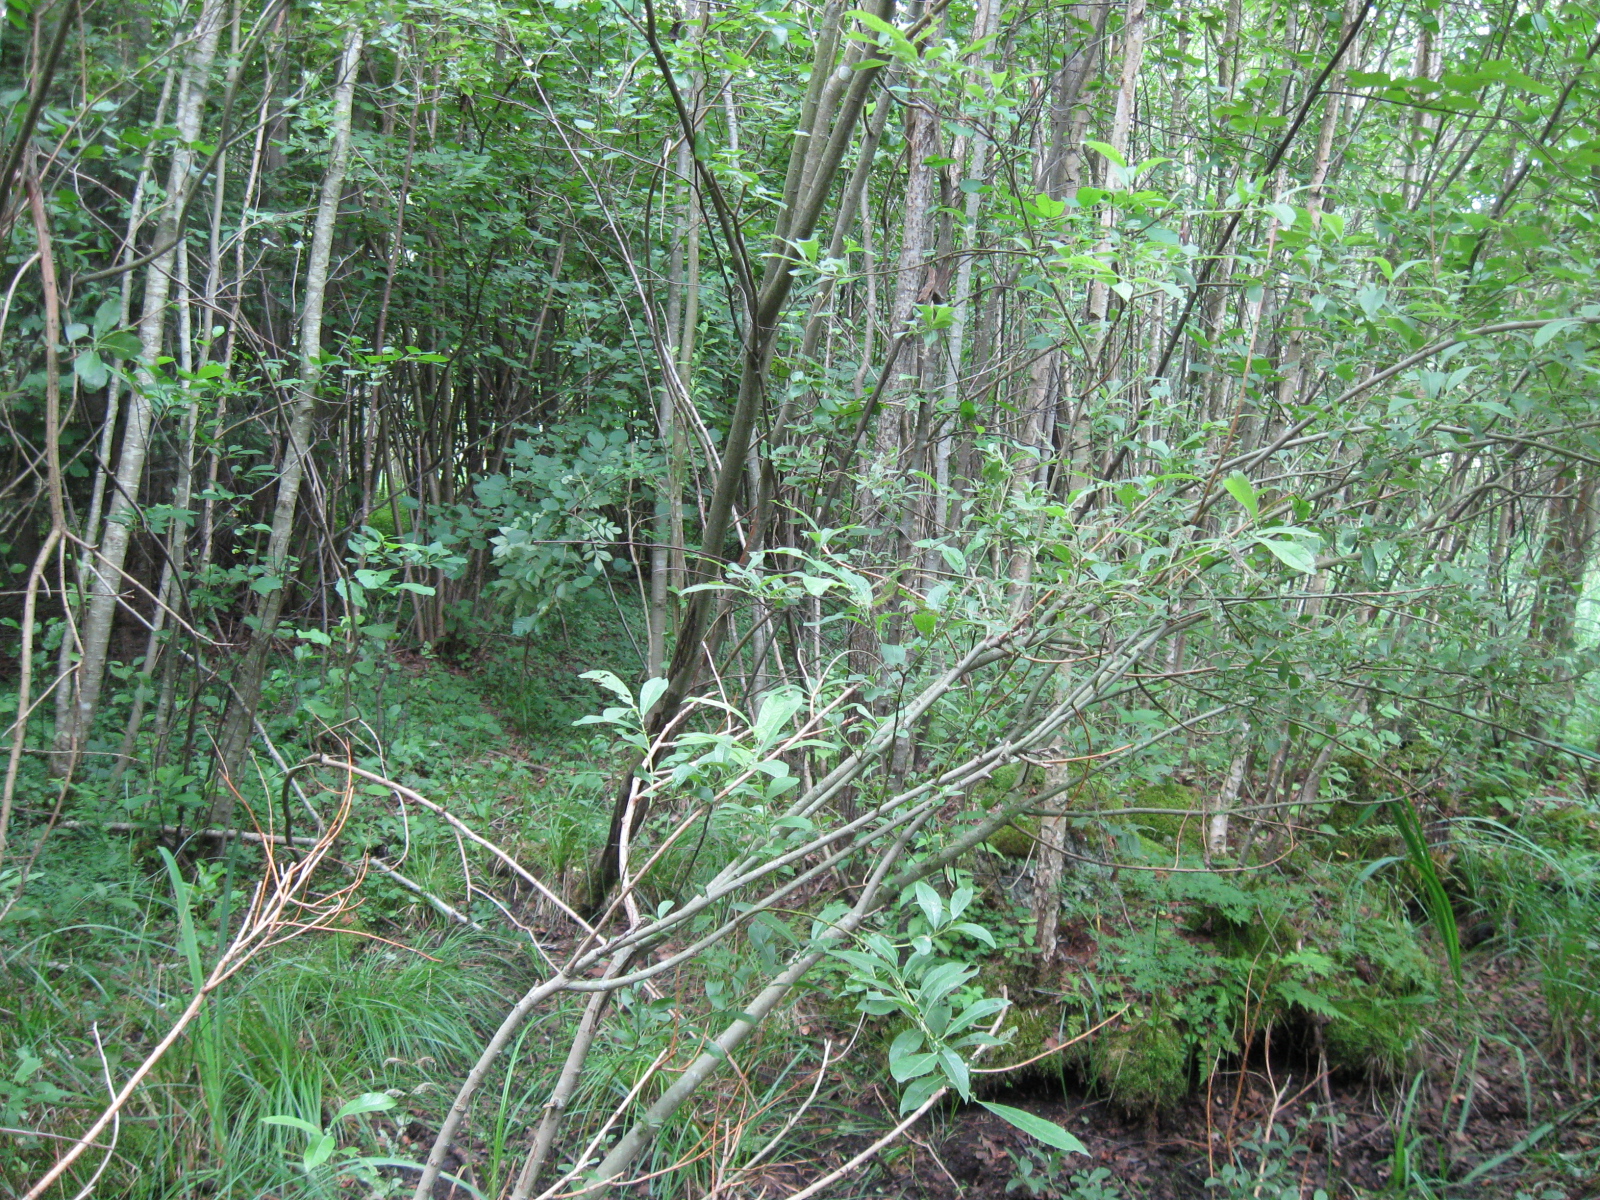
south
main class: Woodland
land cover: Broadleaved woodland
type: floodplain forest
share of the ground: > 75 %
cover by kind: broadleaved forest trees 90 %, herbaceous plants 5 %, unconsolidated bare surface 5 %
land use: Forestry
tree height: > 5 m
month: July
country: LT
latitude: 55.0622
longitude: 23.7223
